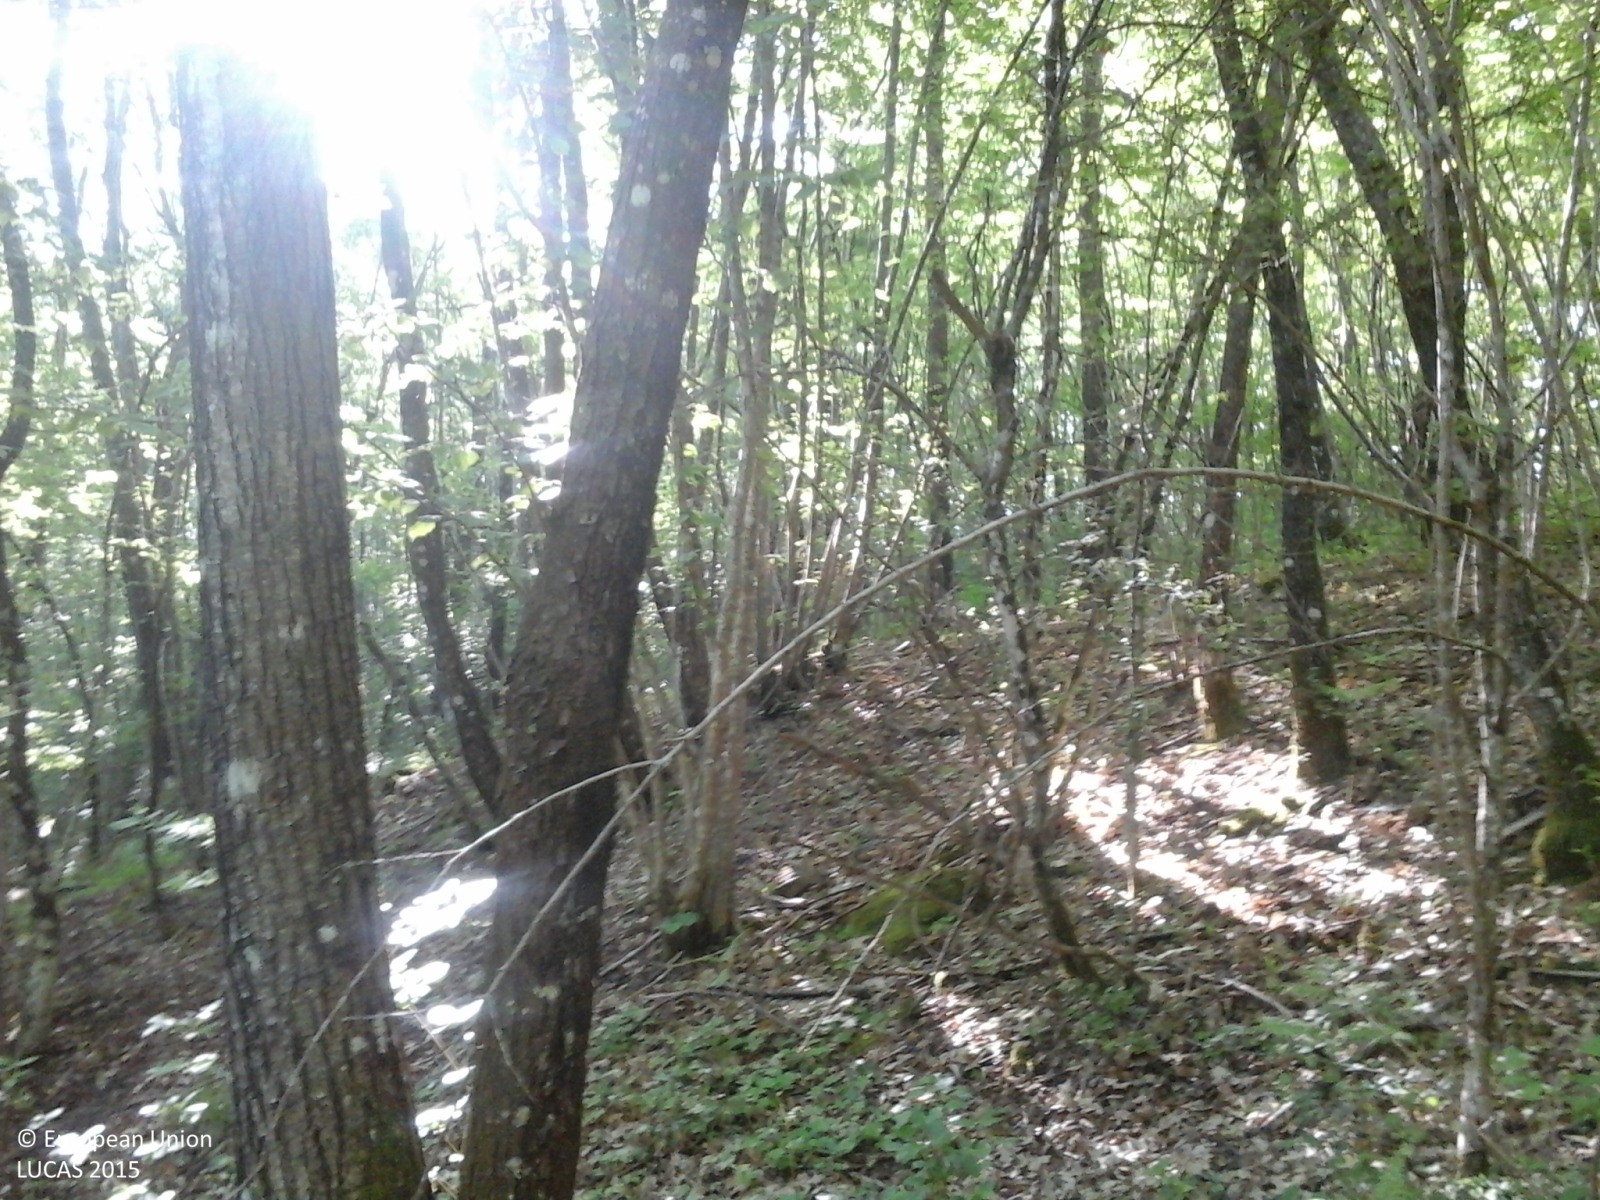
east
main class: Woodland
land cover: Broadleaved woodland
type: thermophilous deciduous forest
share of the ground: > 75 %
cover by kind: broadleaved forest trees 90 %, shrubs 10 %
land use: Forestry
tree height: > 5 m
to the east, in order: Broadleaved woodland; Ditches and canals; Paved roads, cycling and walking lanes; Grass margins; Broadleaved woodland; Grassland with sparse tree/shrub cover; Electric lines; Grassland with sparse tree/shrub cover
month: May
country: IT
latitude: 44.5304
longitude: 9.6861
